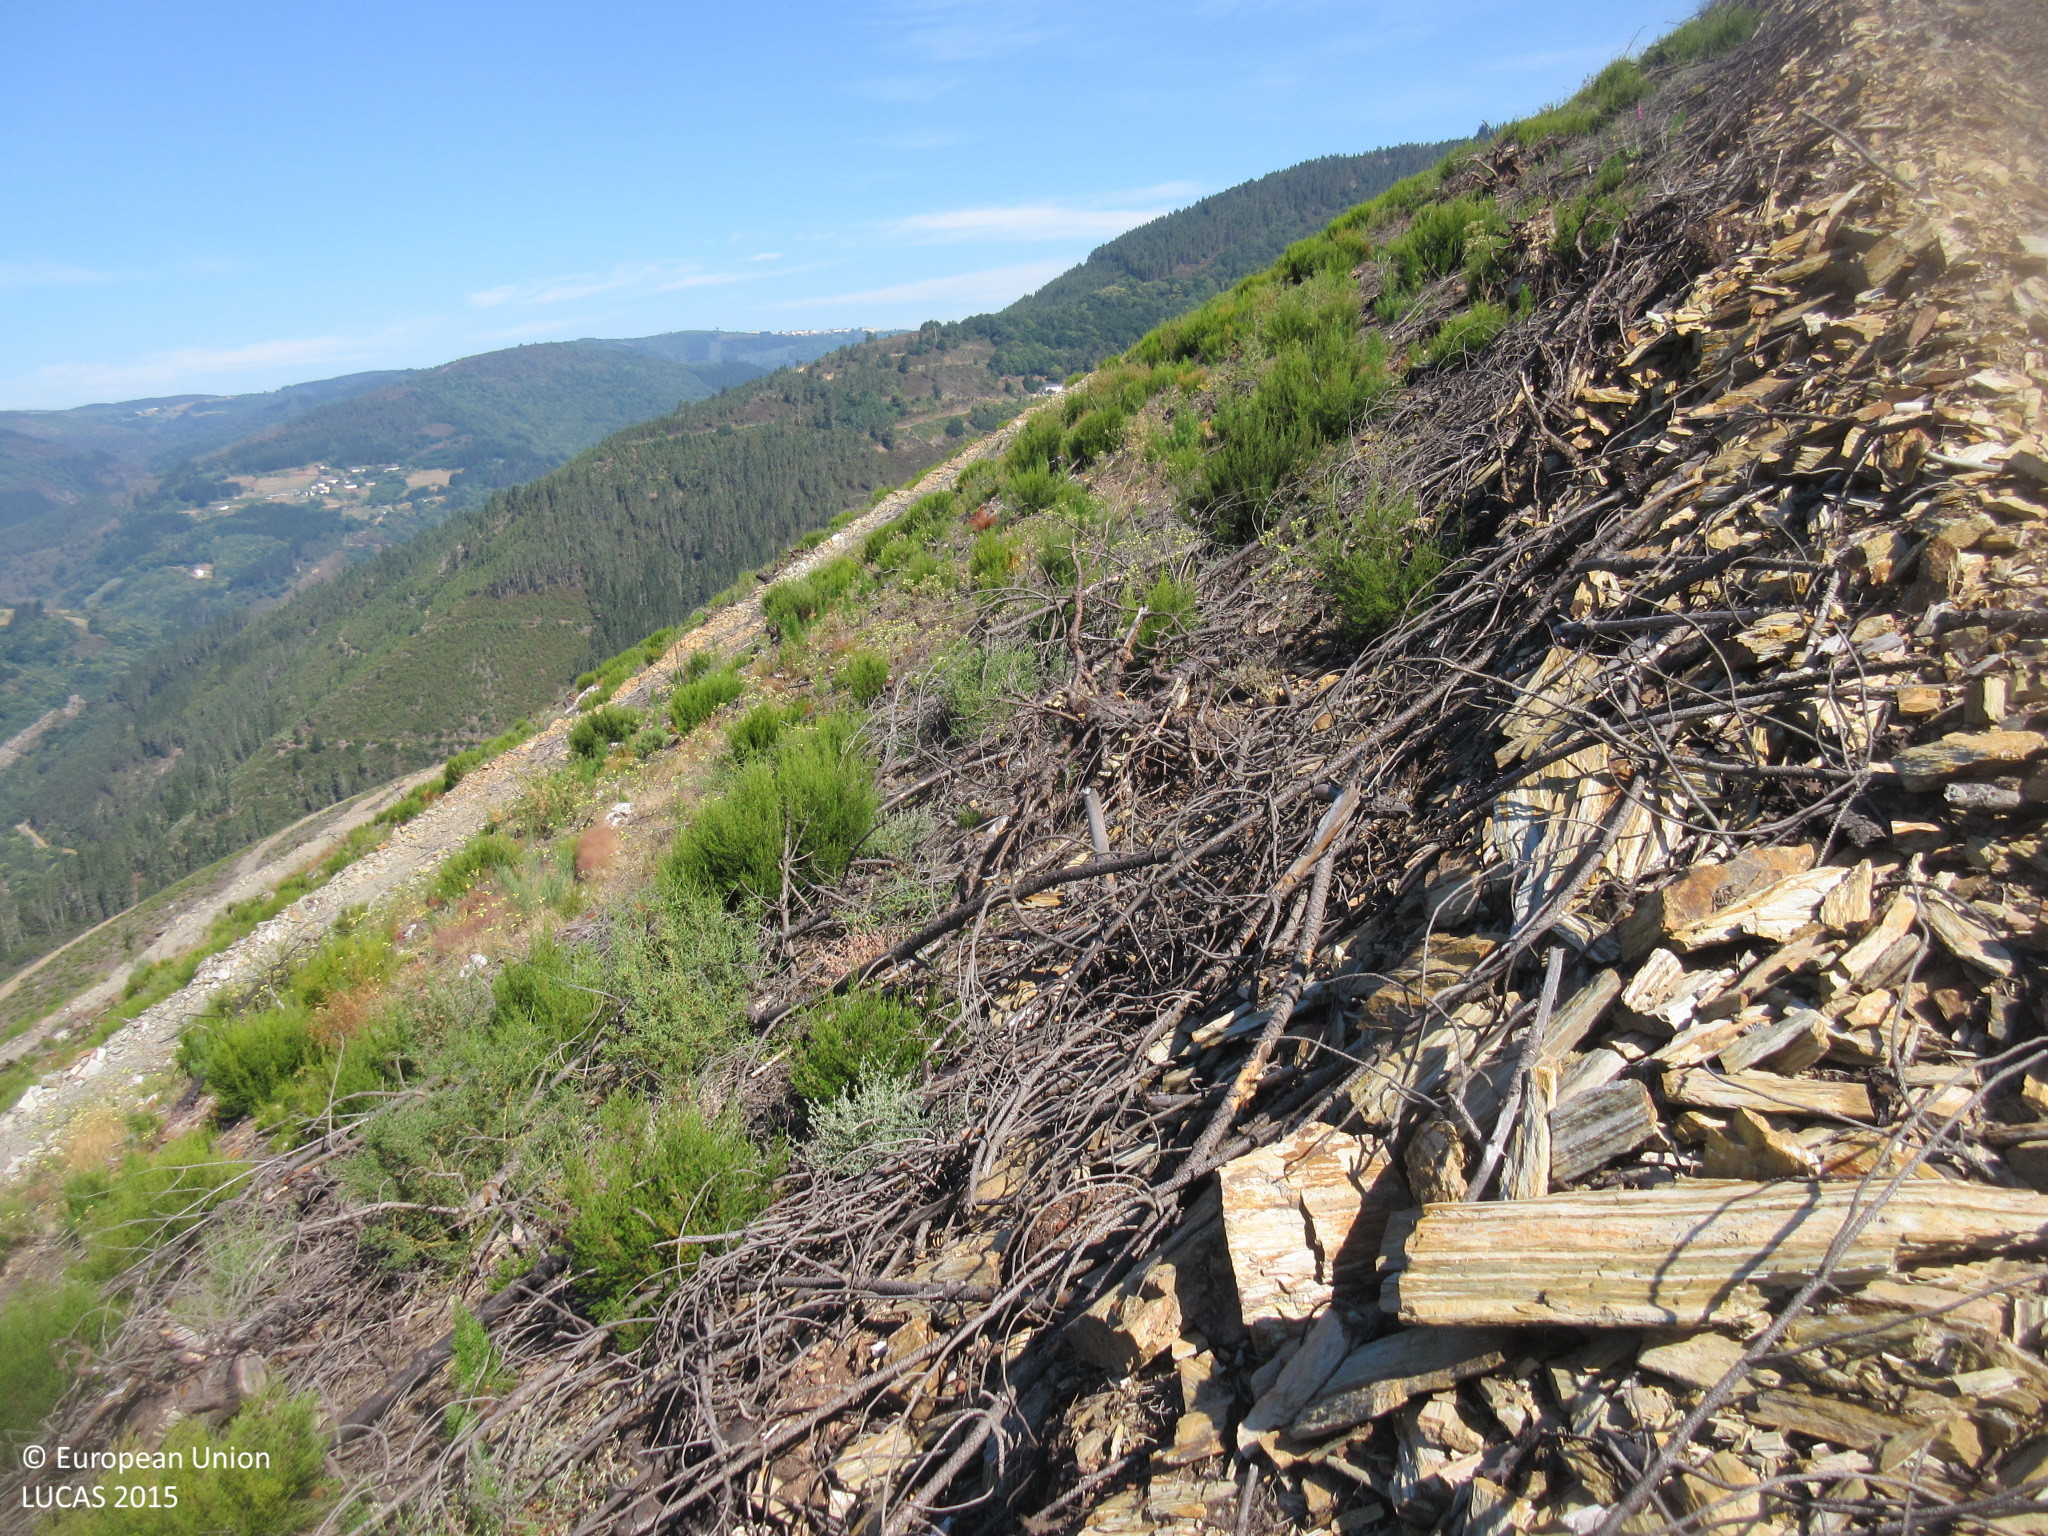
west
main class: Shrubland
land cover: Shrubland without tree cover
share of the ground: 50 - 75 %
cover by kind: shrubs 65 %, unconsolidated bare surface 35 %
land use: Forestry
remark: Clear cut
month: June
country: ES
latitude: 43.0822
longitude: -7.0015
